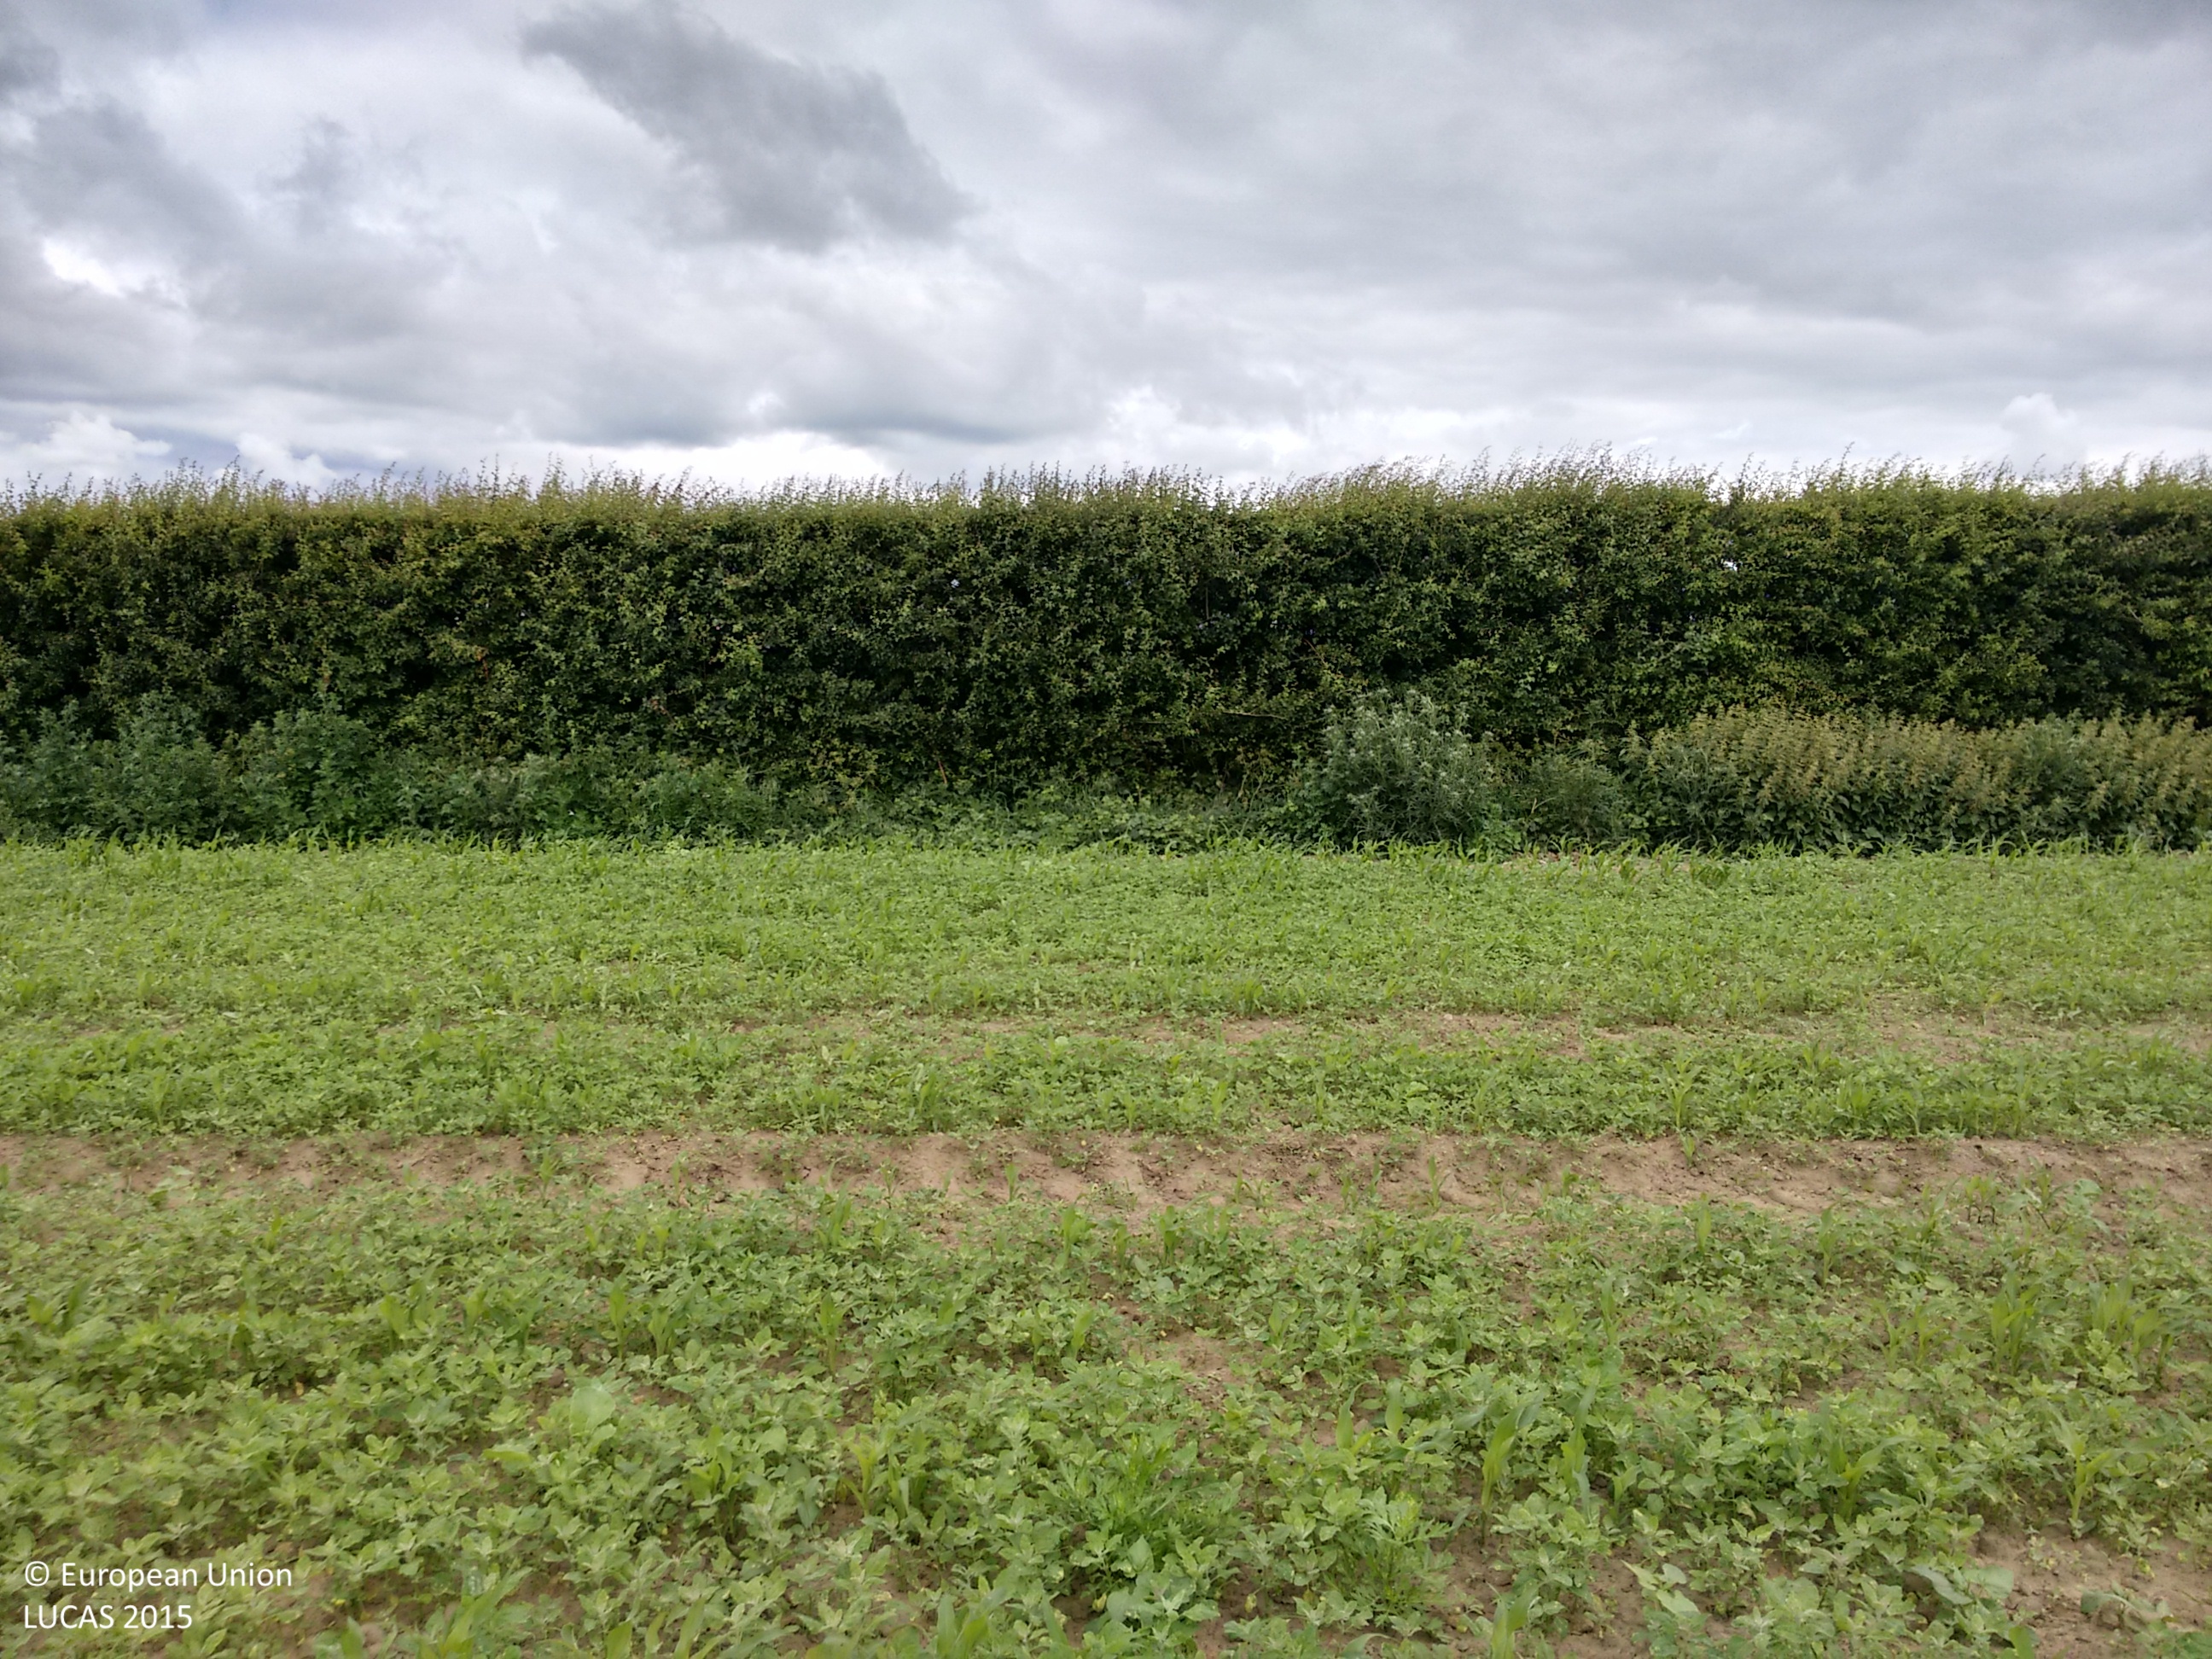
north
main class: Cropland
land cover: Common wheat
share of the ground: > 75 %
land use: Agriculture (excluding fallow land and kitchen gardens)
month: June
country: GB
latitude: 53.7461
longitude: -1.0678
